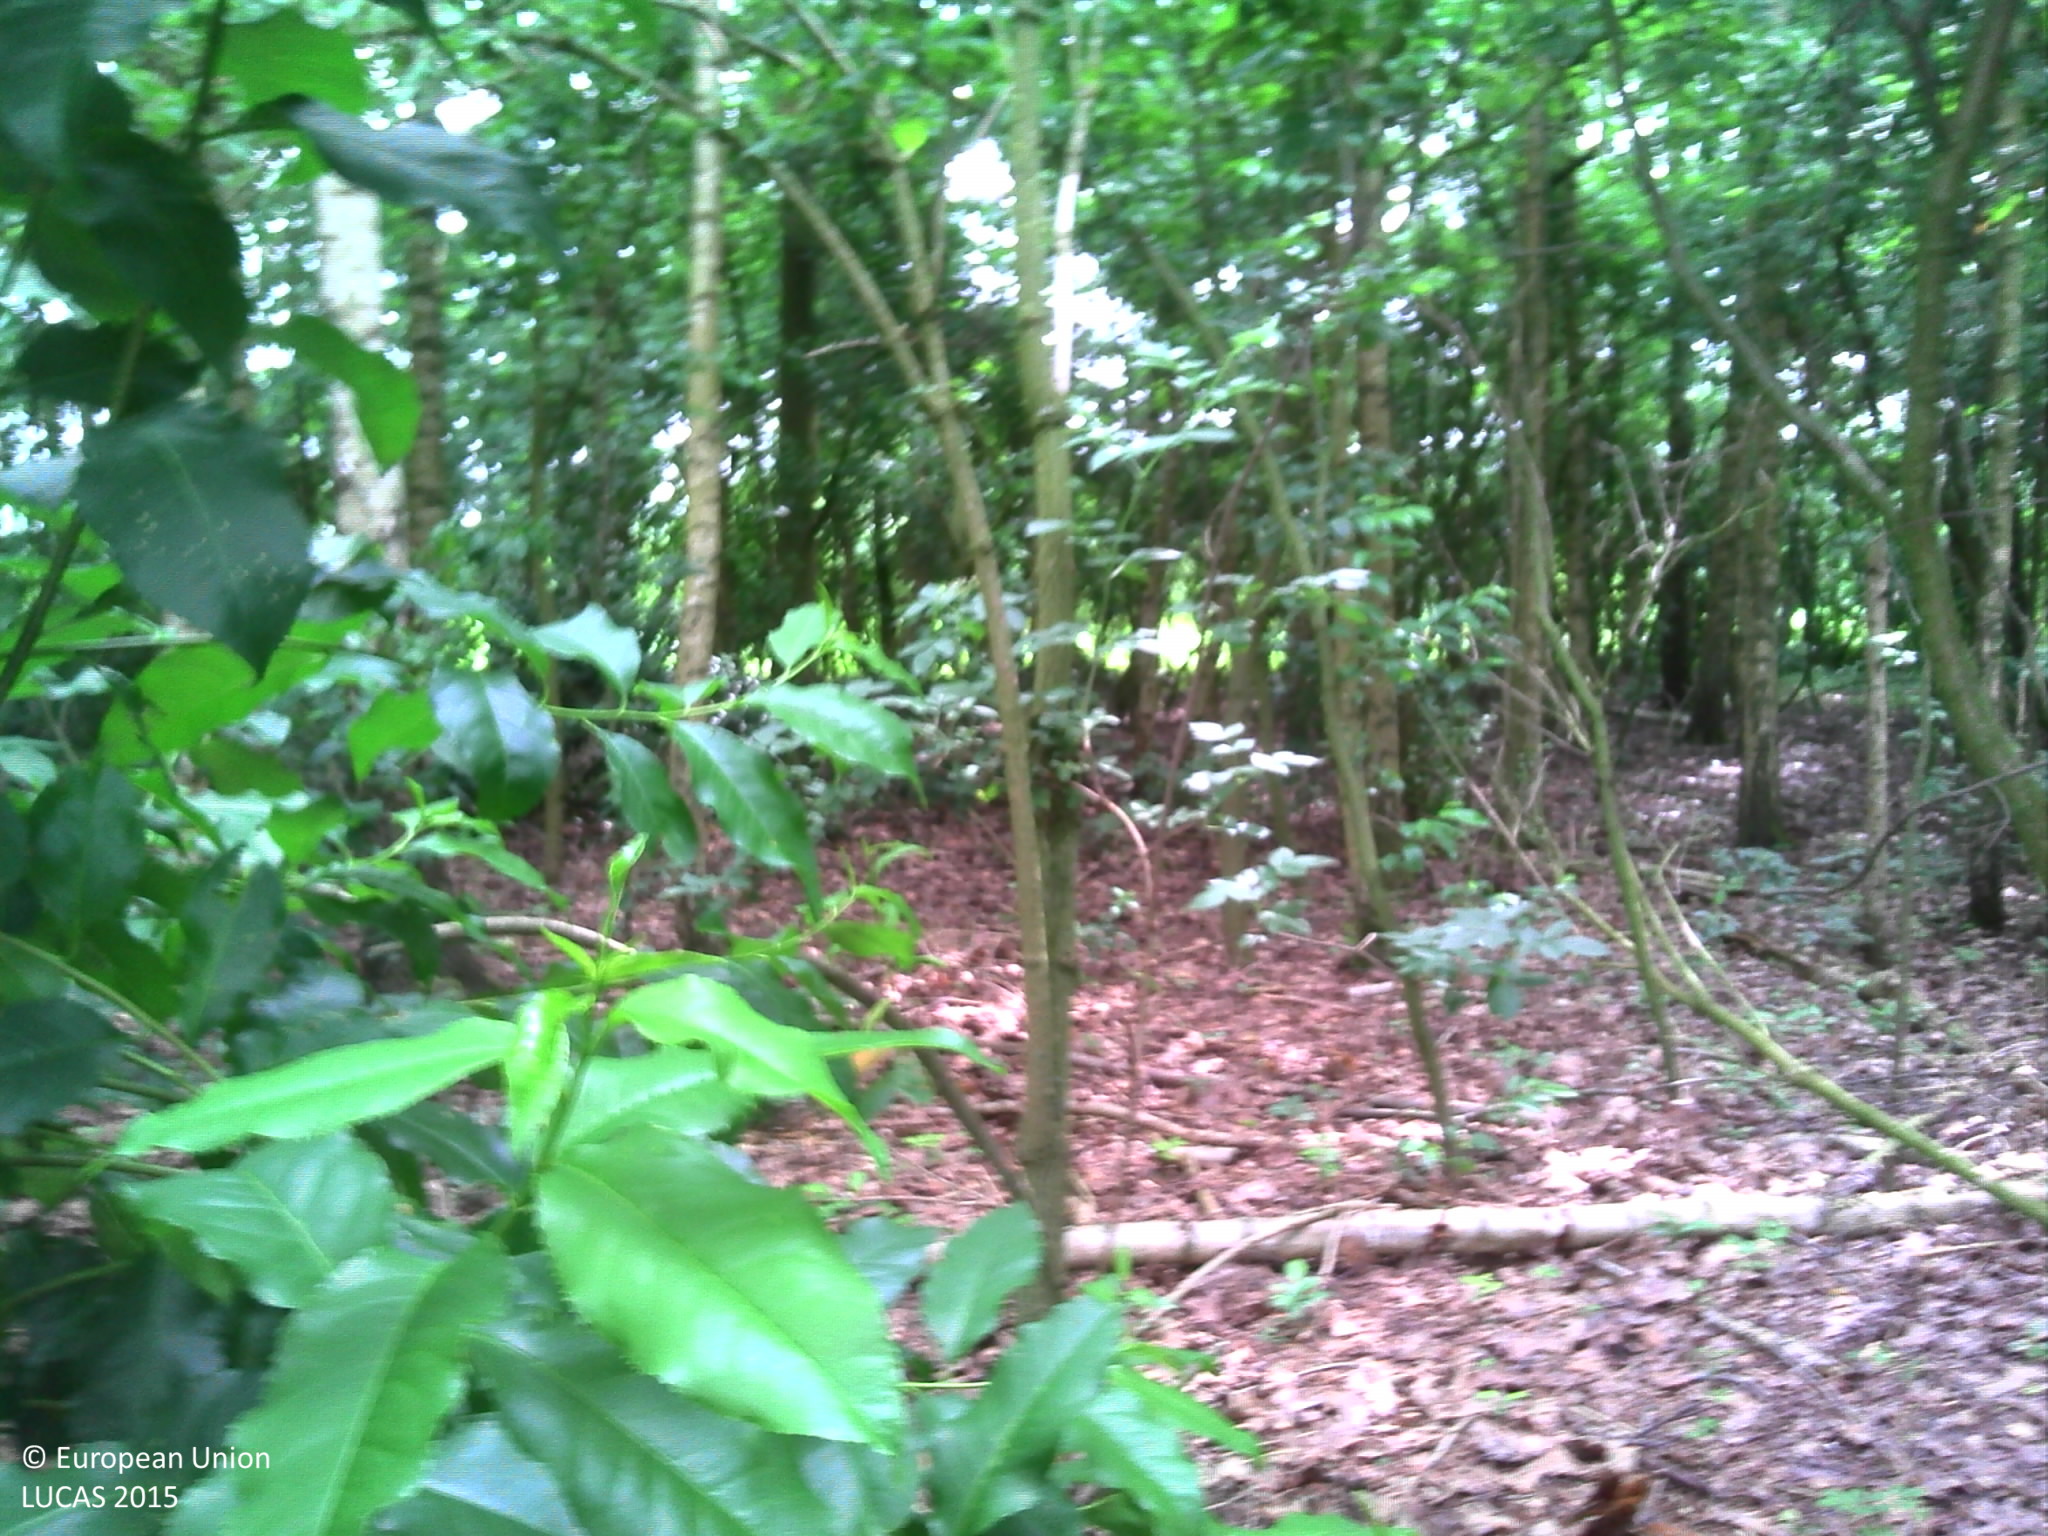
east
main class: Woodland
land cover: Broadleaved woodland
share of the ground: > 75 %
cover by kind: broadleaved forest trees 100 %
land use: Forestry
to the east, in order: Broadleaved woodland; Ditches and canals; Grass margins; Maize; Grass margins; Ditches and canals; Grass margins; Maize; Fences; Grass margins; Ditches and canals; Ponds and wetlands; Grass margins; Abandoned hedges; Fences; Grassland without tree/shrub cover; Fences; Ditches and canals; Fences; Grassland without tree/shrub cover; Fences; Ditches and canals; Grassland without tree/shrub cover; Fences; Ditches and canals; Fences; Grassland without tree/shrub cover
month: June
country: BE
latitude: 50.9978
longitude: 3.6234
